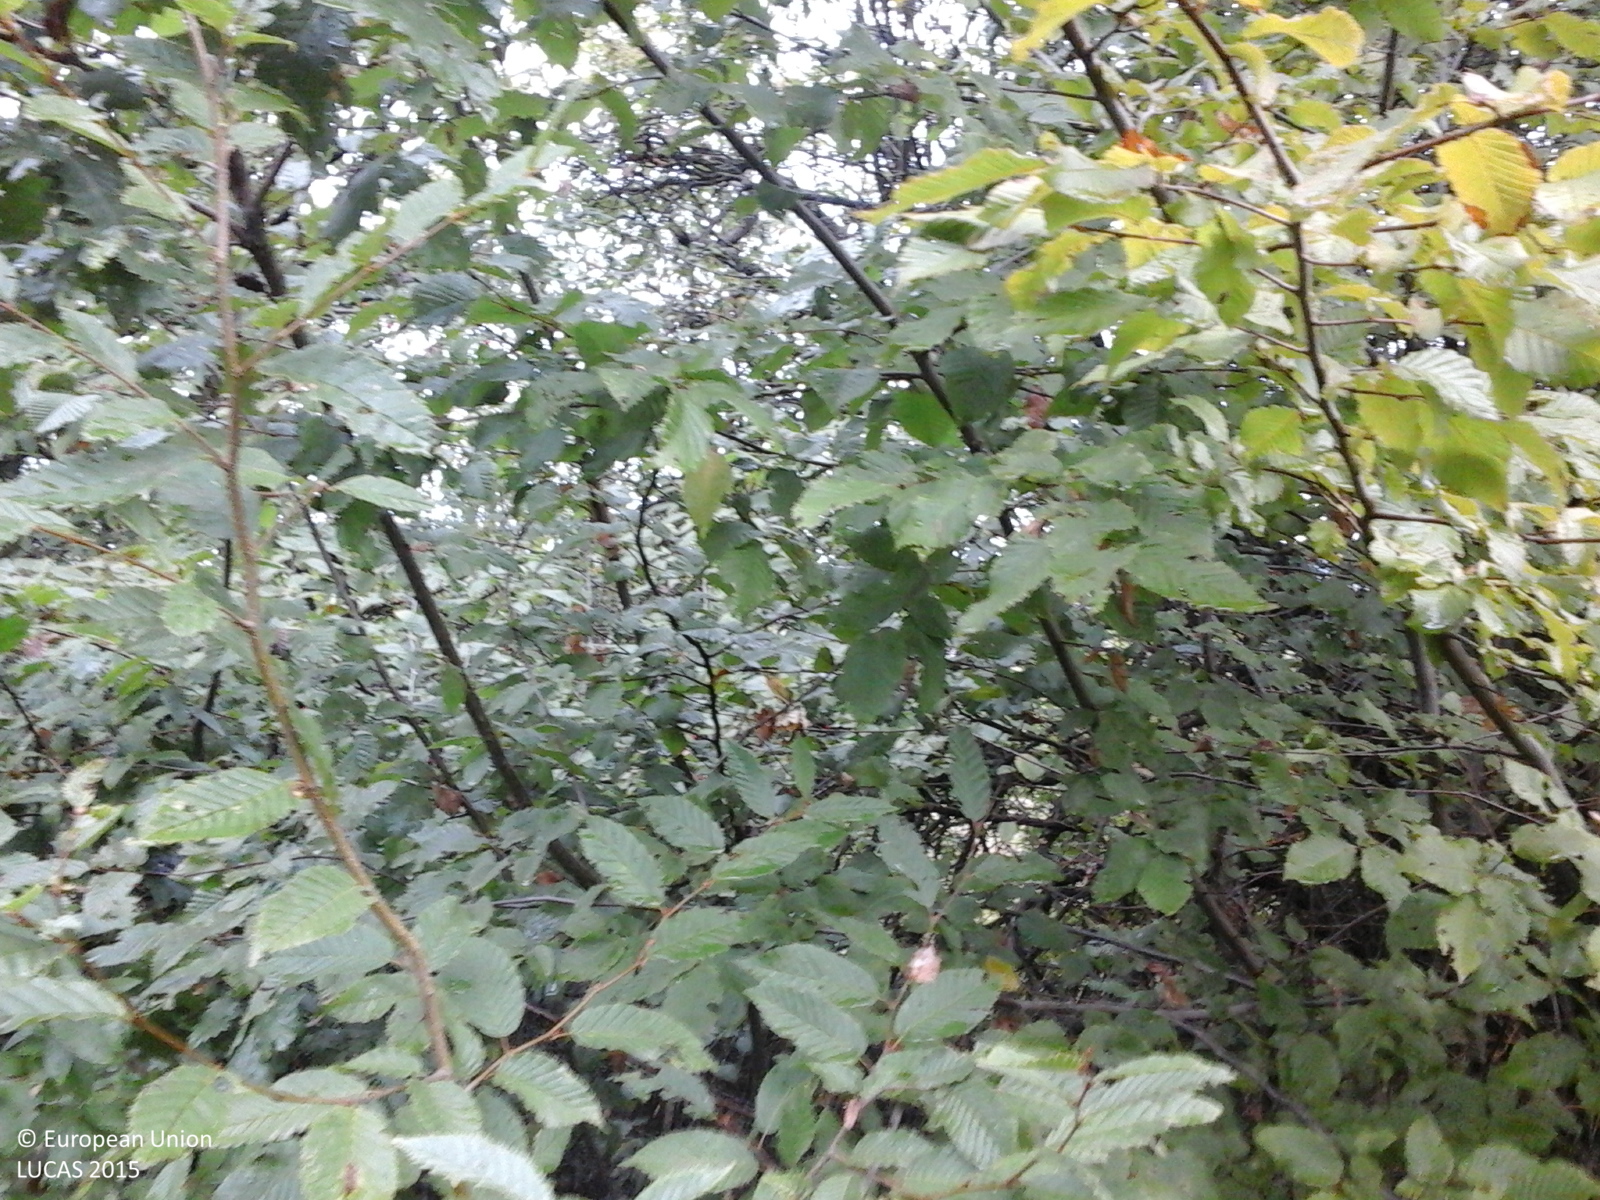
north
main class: Woodland
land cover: Broadleaved woodland
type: beech forest
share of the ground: > 75 %
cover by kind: broadleaved forest trees 100 %
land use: Forestry
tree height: > 5 m
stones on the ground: < 10 %
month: September
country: RO
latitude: 47.1343
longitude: 22.1128
